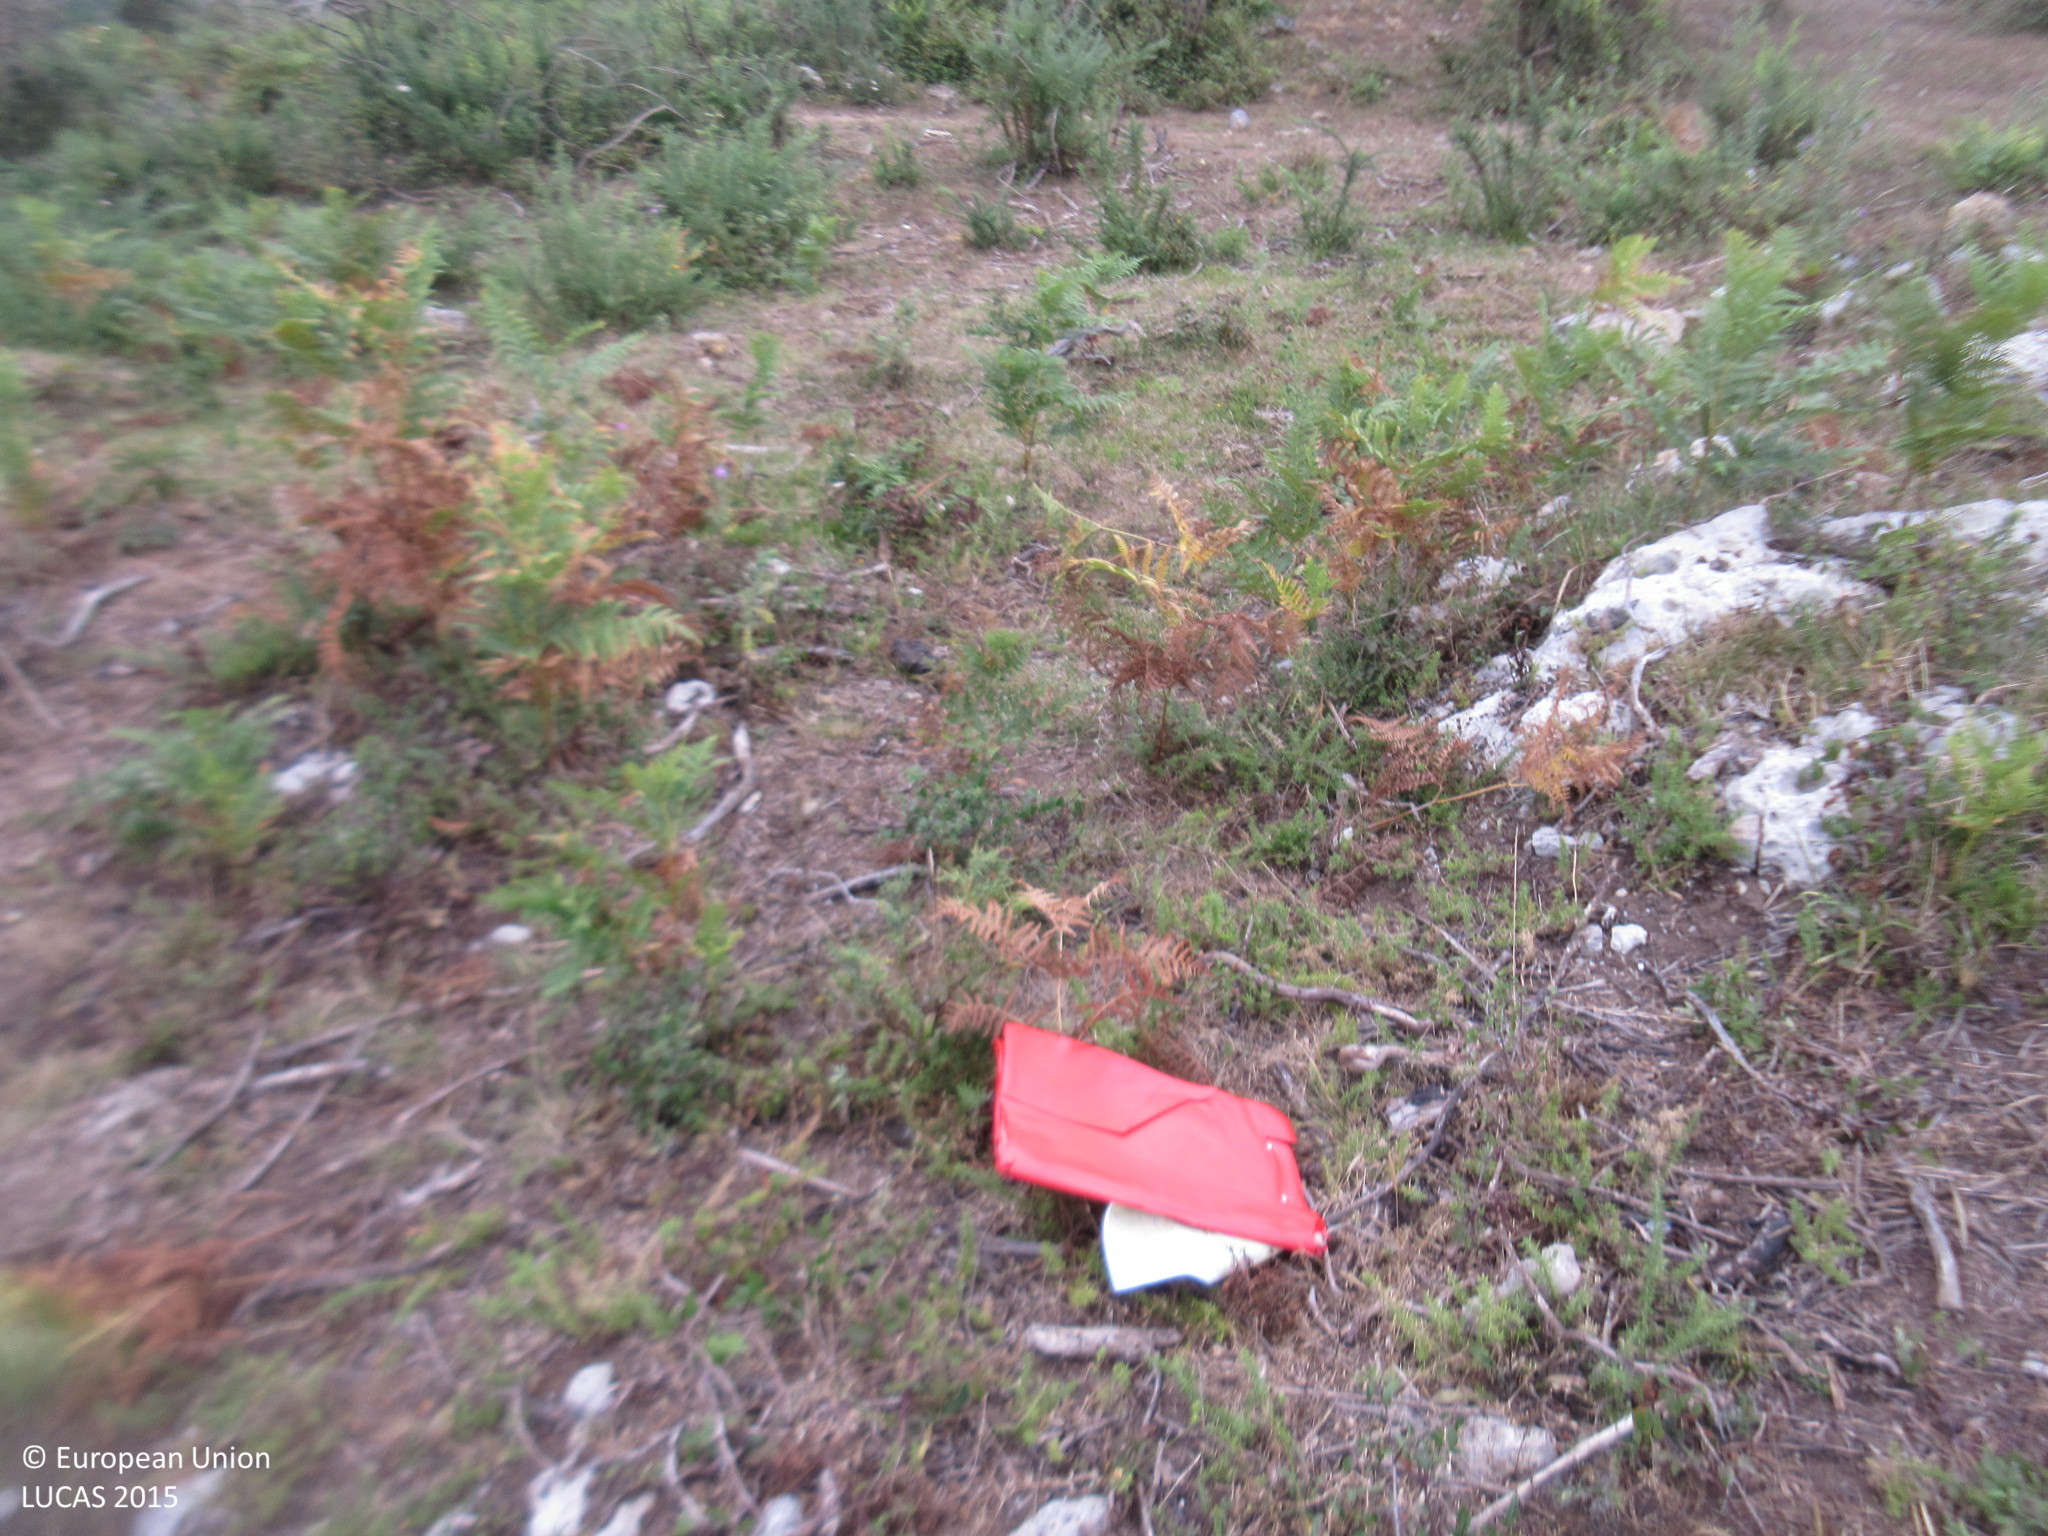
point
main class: Shrubland
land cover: Shrubland without tree cover
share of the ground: > 75 %
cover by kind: shrubs 100 %
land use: Agriculture (excluding fallow land and kitchen gardens)
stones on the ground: > 50 %
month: July
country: ES
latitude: 43.1859
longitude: -4.0649
